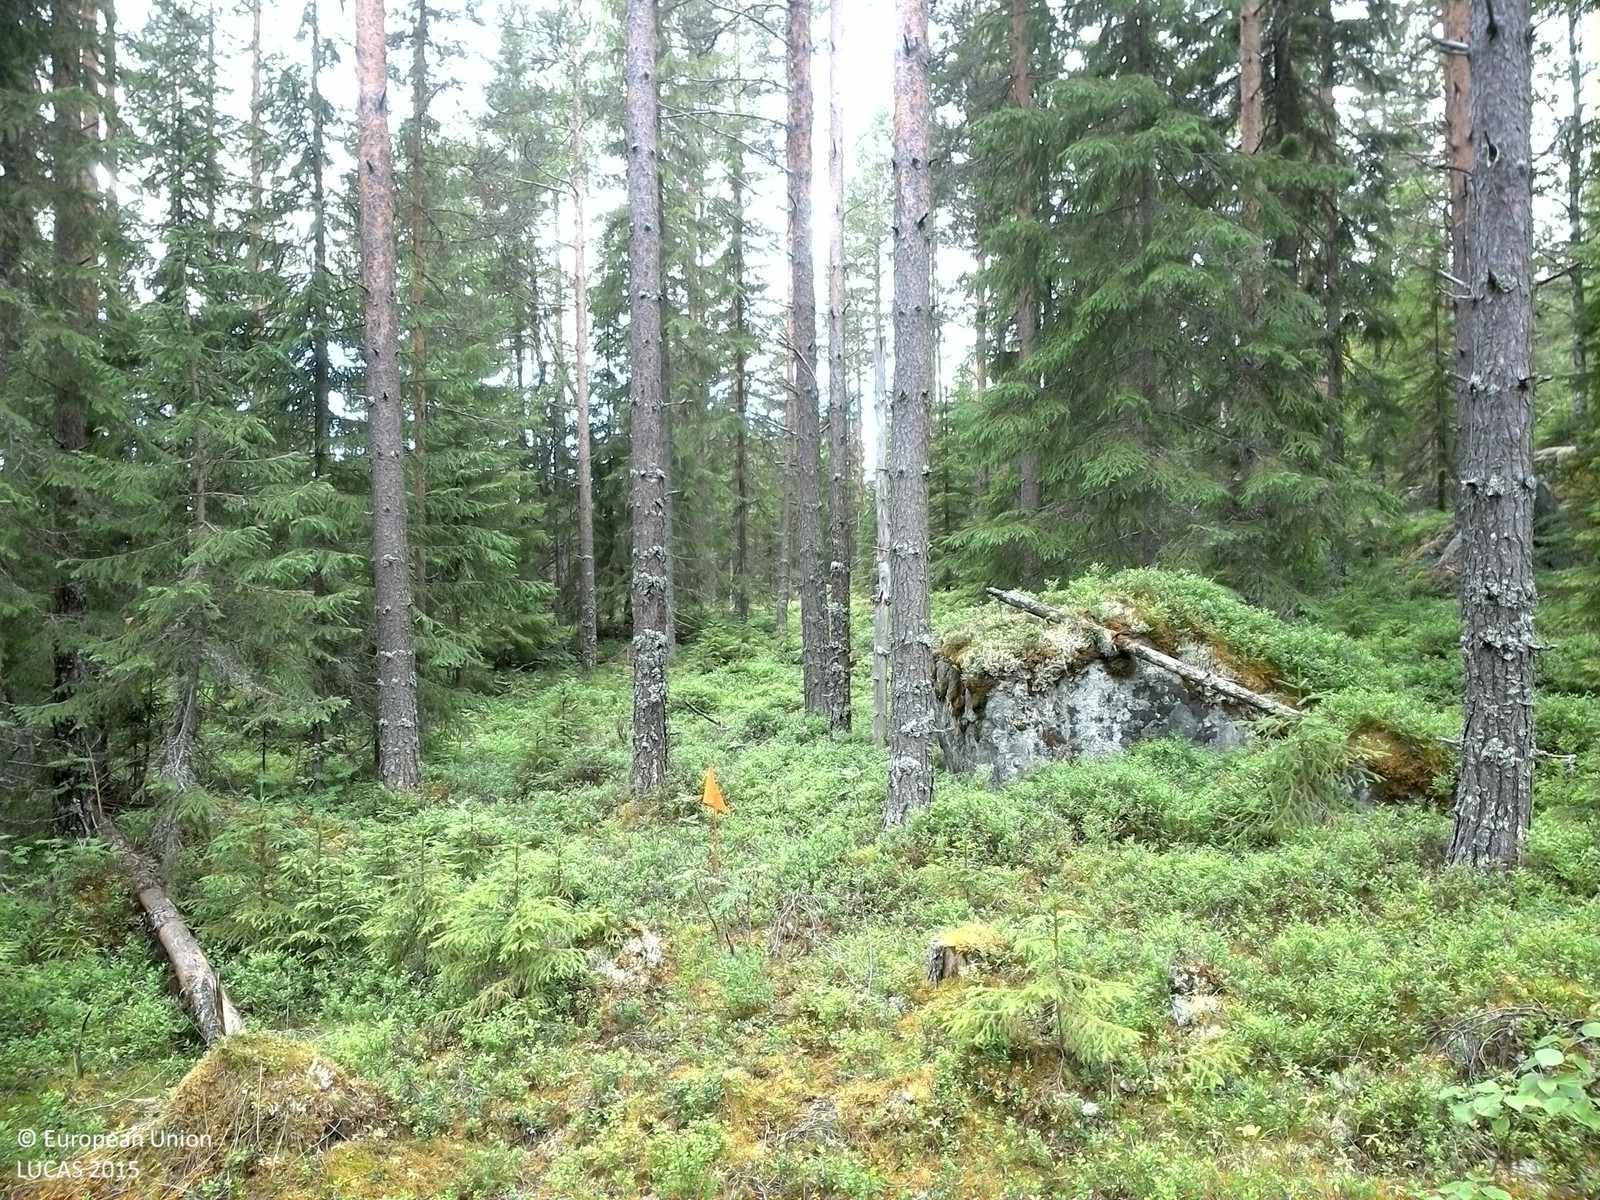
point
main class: Woodland
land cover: Pine dominated coniferous woodland
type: boreal forest
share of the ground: 50 - 75 %
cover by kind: coniferous forest trees 50 %, shrubs 30 %, lichens and mosses 10 %, broadleaved forest trees 5 %, herbaceous plants 5 %
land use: Forestry
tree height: > 5 m
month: July
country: SE
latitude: 62.7176
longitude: 17.0768
